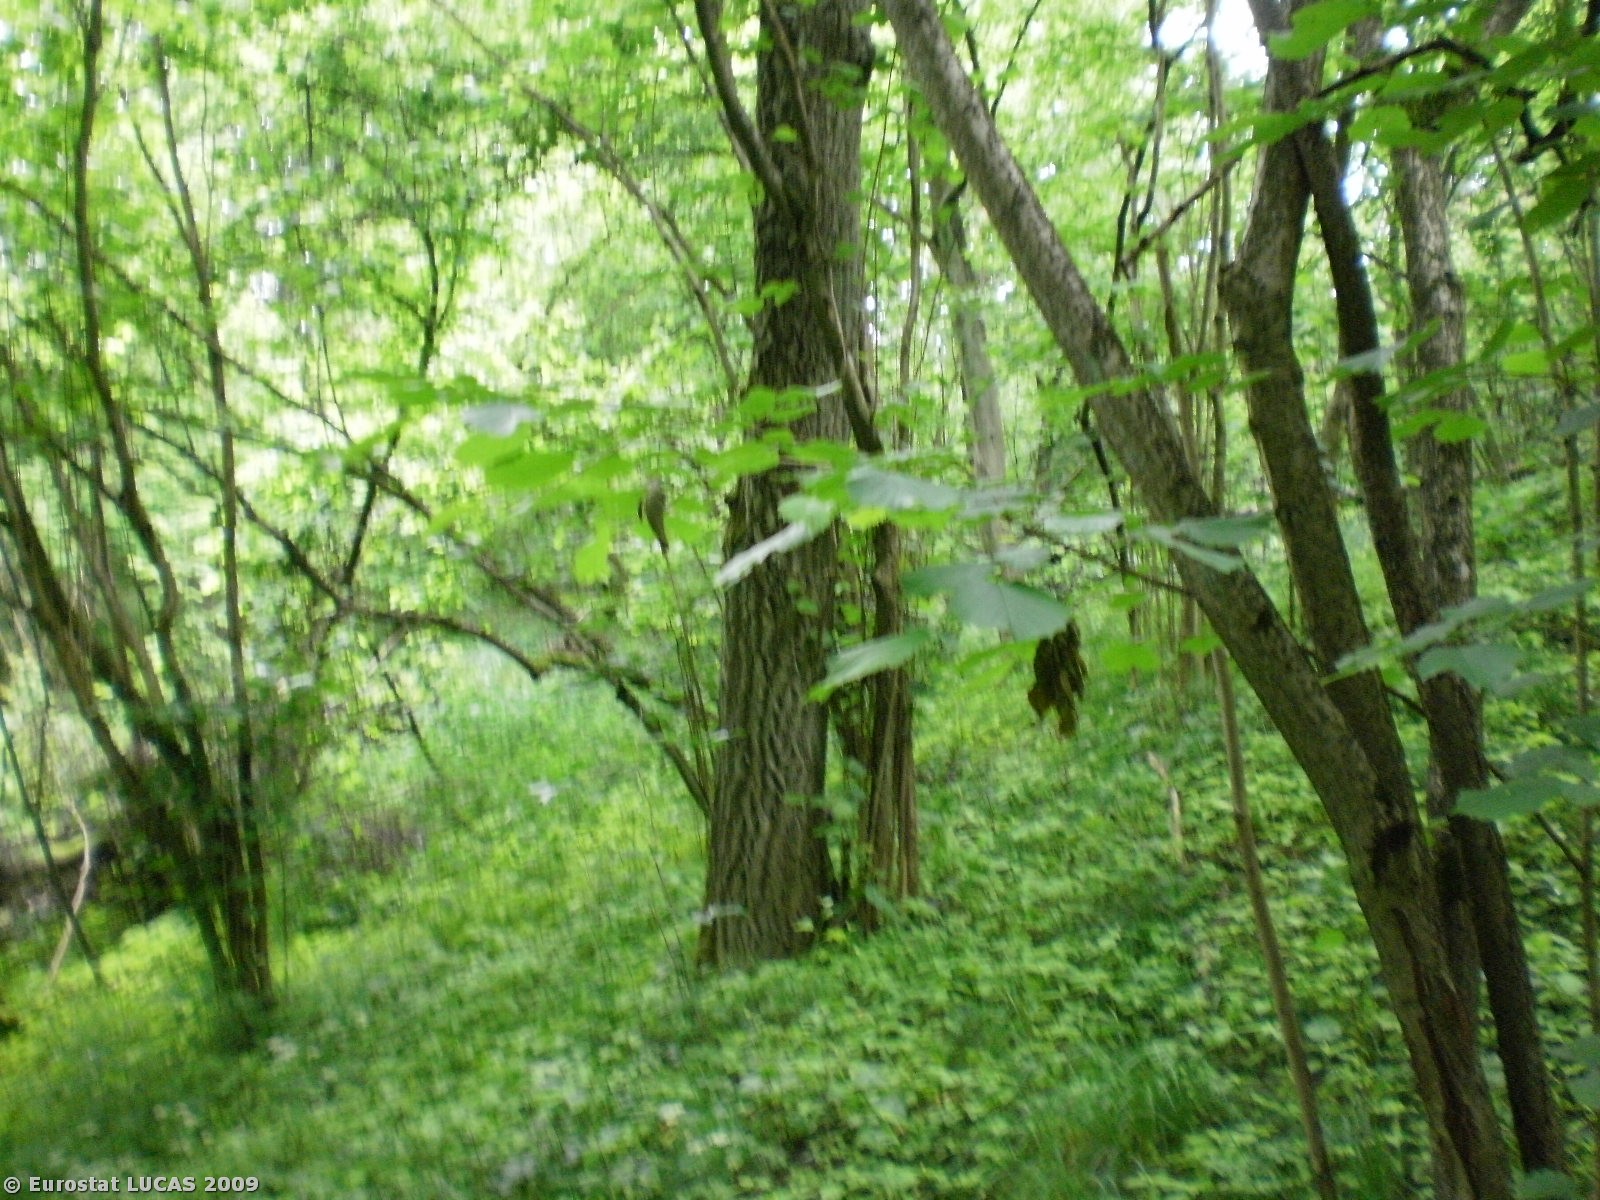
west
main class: Woodland
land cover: Mixed woodland
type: hemiboreal forest and nemoral coniferous forest and mixed broadleaved-coniferous forest
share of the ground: > 75 %
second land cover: Shrubland with sparse tree cover
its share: 10 - 25 %
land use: Forestry
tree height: > 5 m
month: June
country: PL
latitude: 53.3317
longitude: 19.7749
